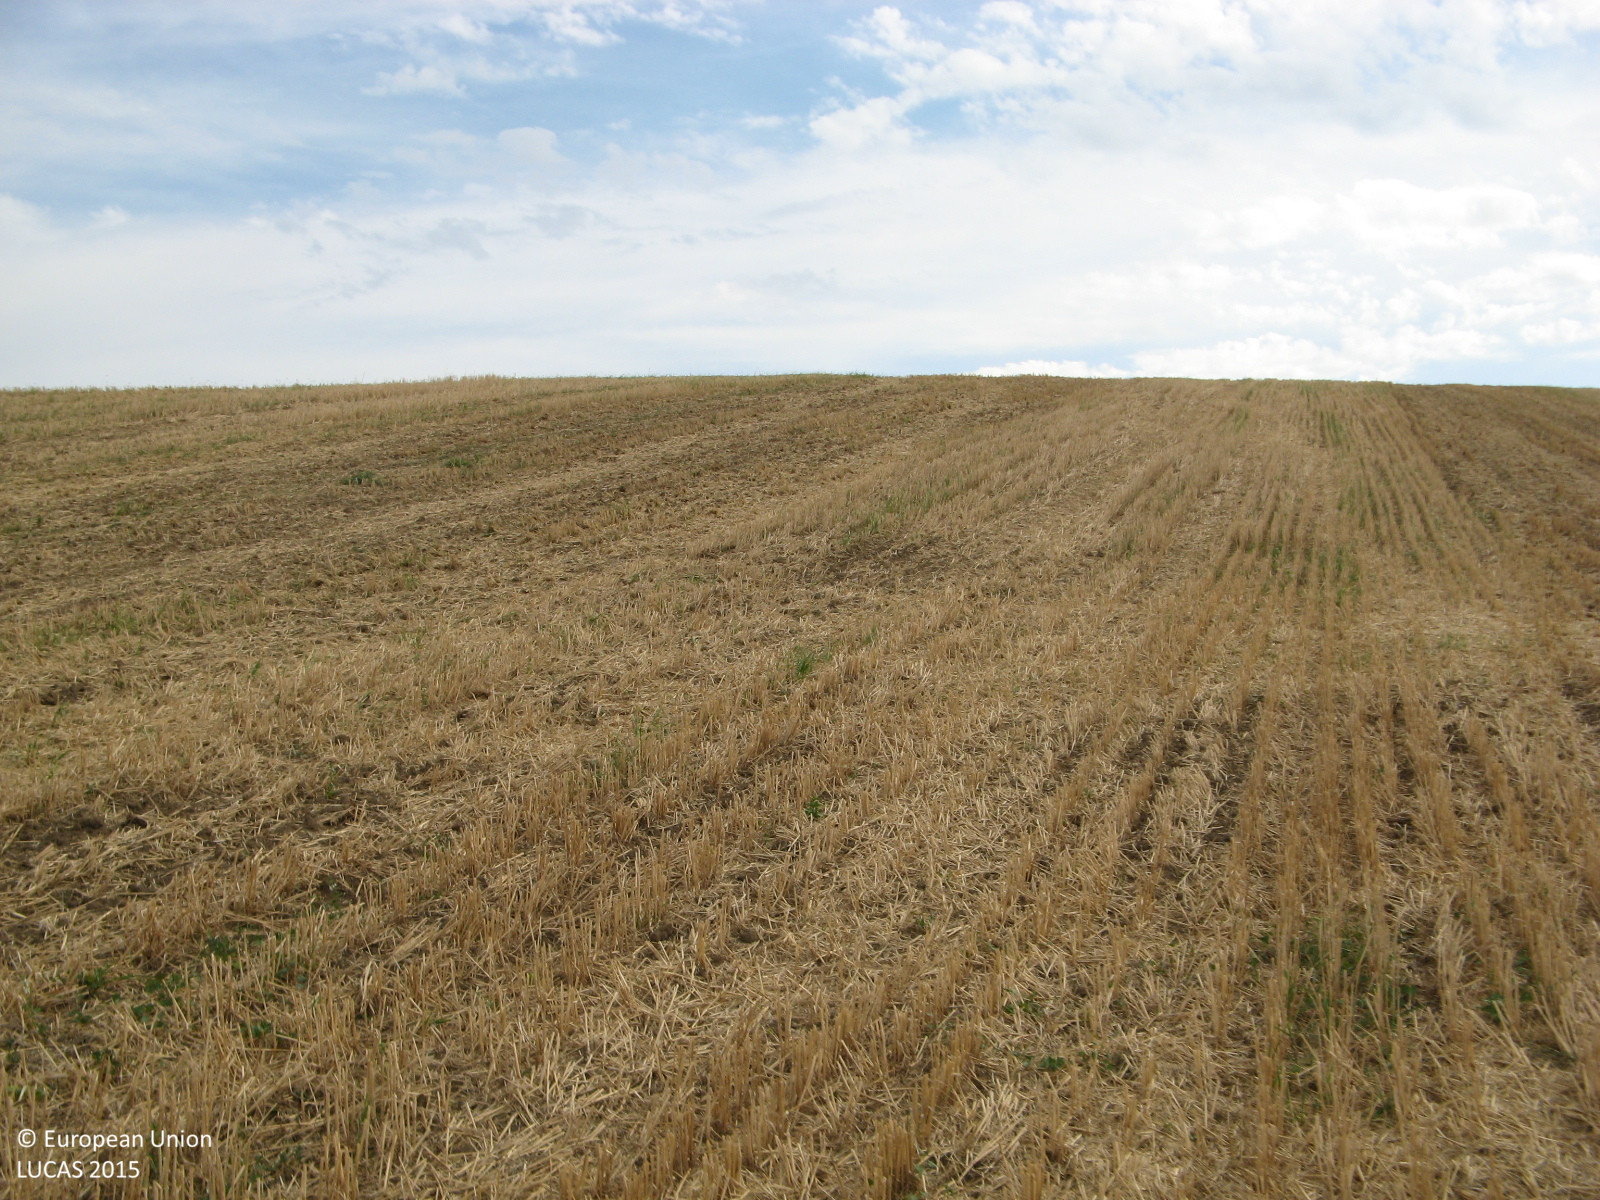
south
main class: Cropland
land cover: Common wheat
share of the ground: 25 - 50 %
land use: Agriculture (excluding fallow land and kitchen gardens)
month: August
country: BG
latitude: 43.6603
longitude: 25.6997
